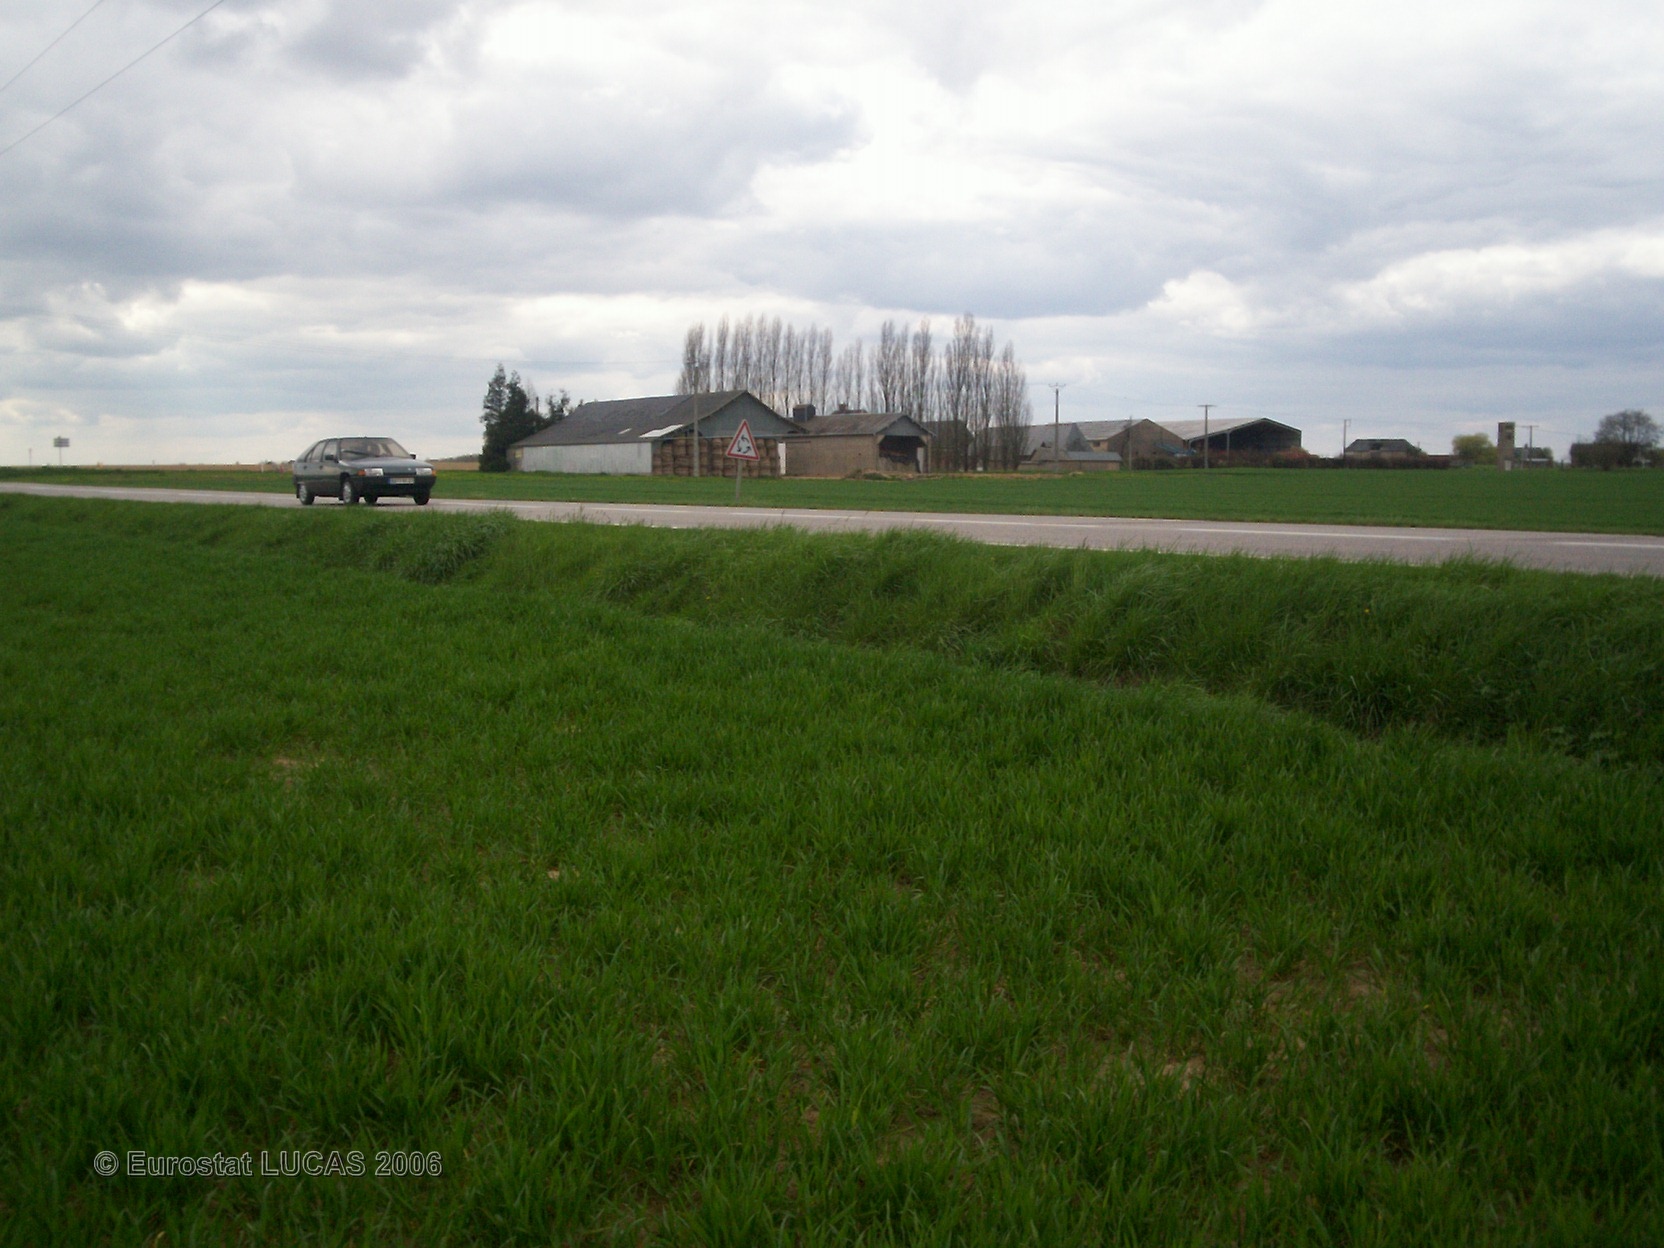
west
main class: Cropland
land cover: Common wheat
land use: Agriculture (excluding fallow land and kitchen gardens)
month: April
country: FR
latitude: 49.1578
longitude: 0.9965
